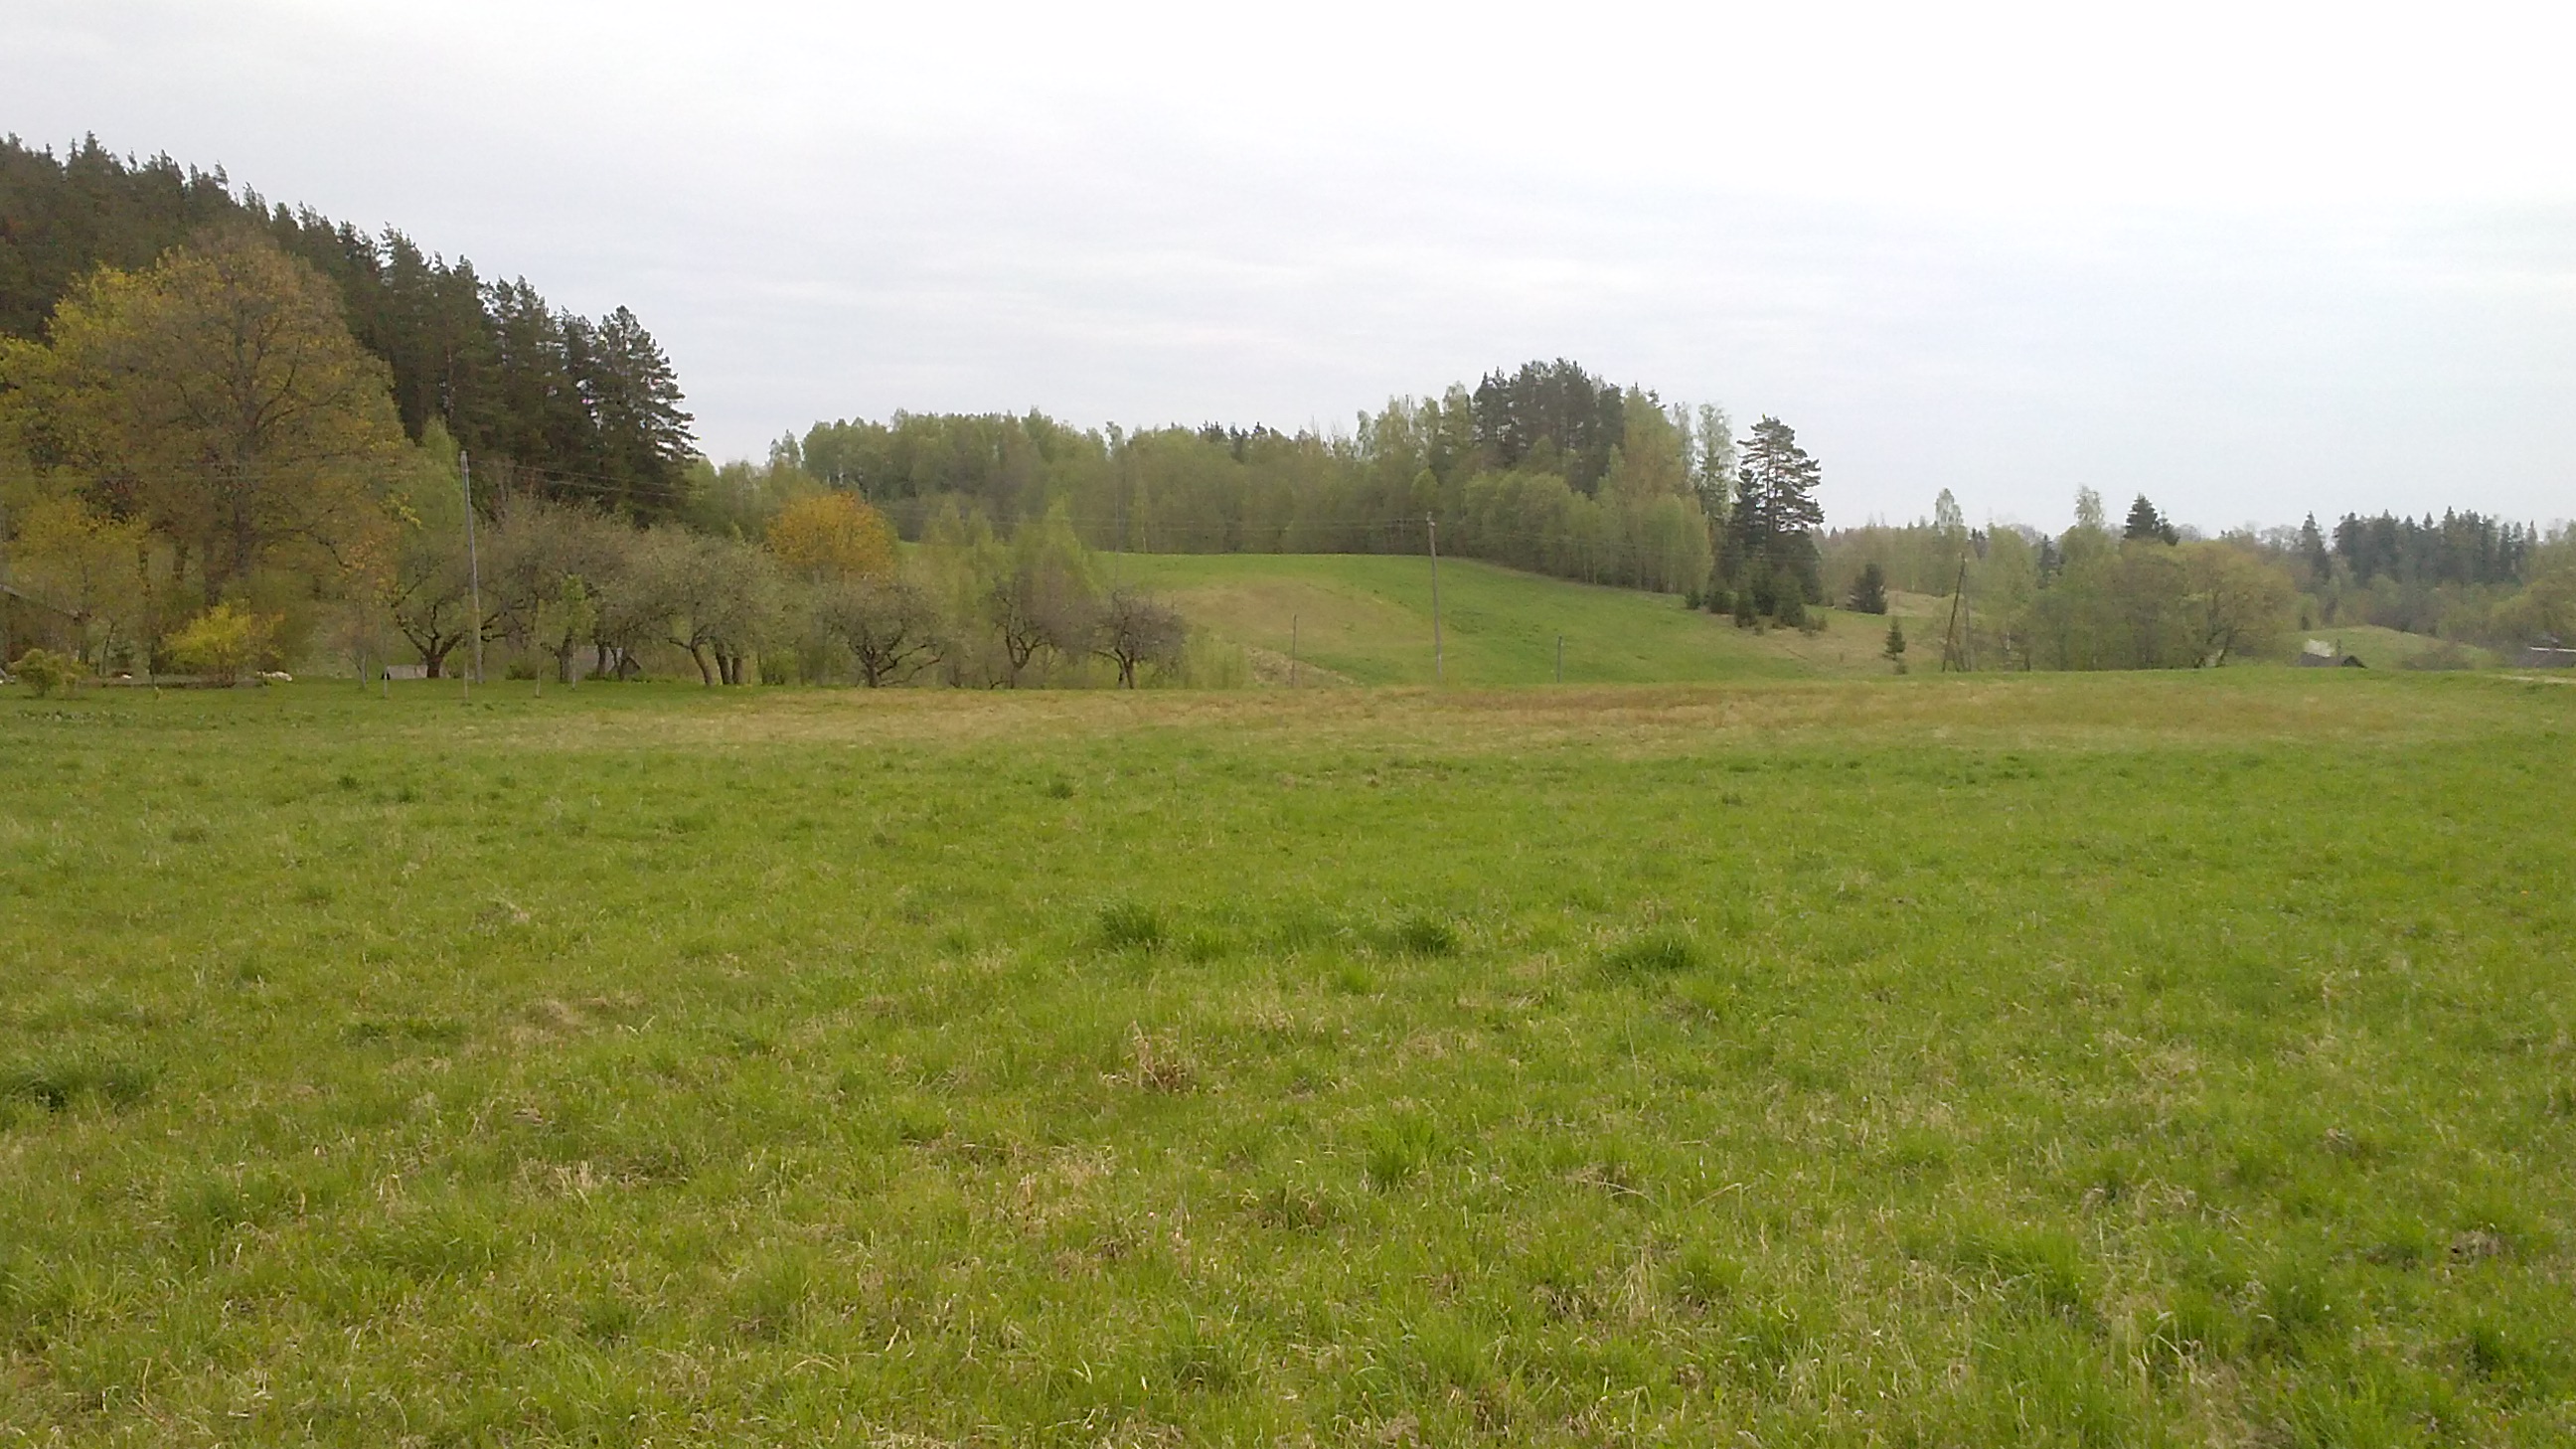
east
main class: Grassland
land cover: Grassland without tree/shrub cover
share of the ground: > 75 %
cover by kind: herbaceous plants 100 %
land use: Agriculture (excluding fallow land and kitchen gardens)
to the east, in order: Grassland without tree/shrub cover; Apple fruit; Electric lines; Apple fruit; Artificial constructions in urban areas; Grassland with sparse tree/shrub cover; Broadleaved woodland; Spruce dominated coniferous woodland
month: May
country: LV
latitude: 55.9579
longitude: 27.1652
